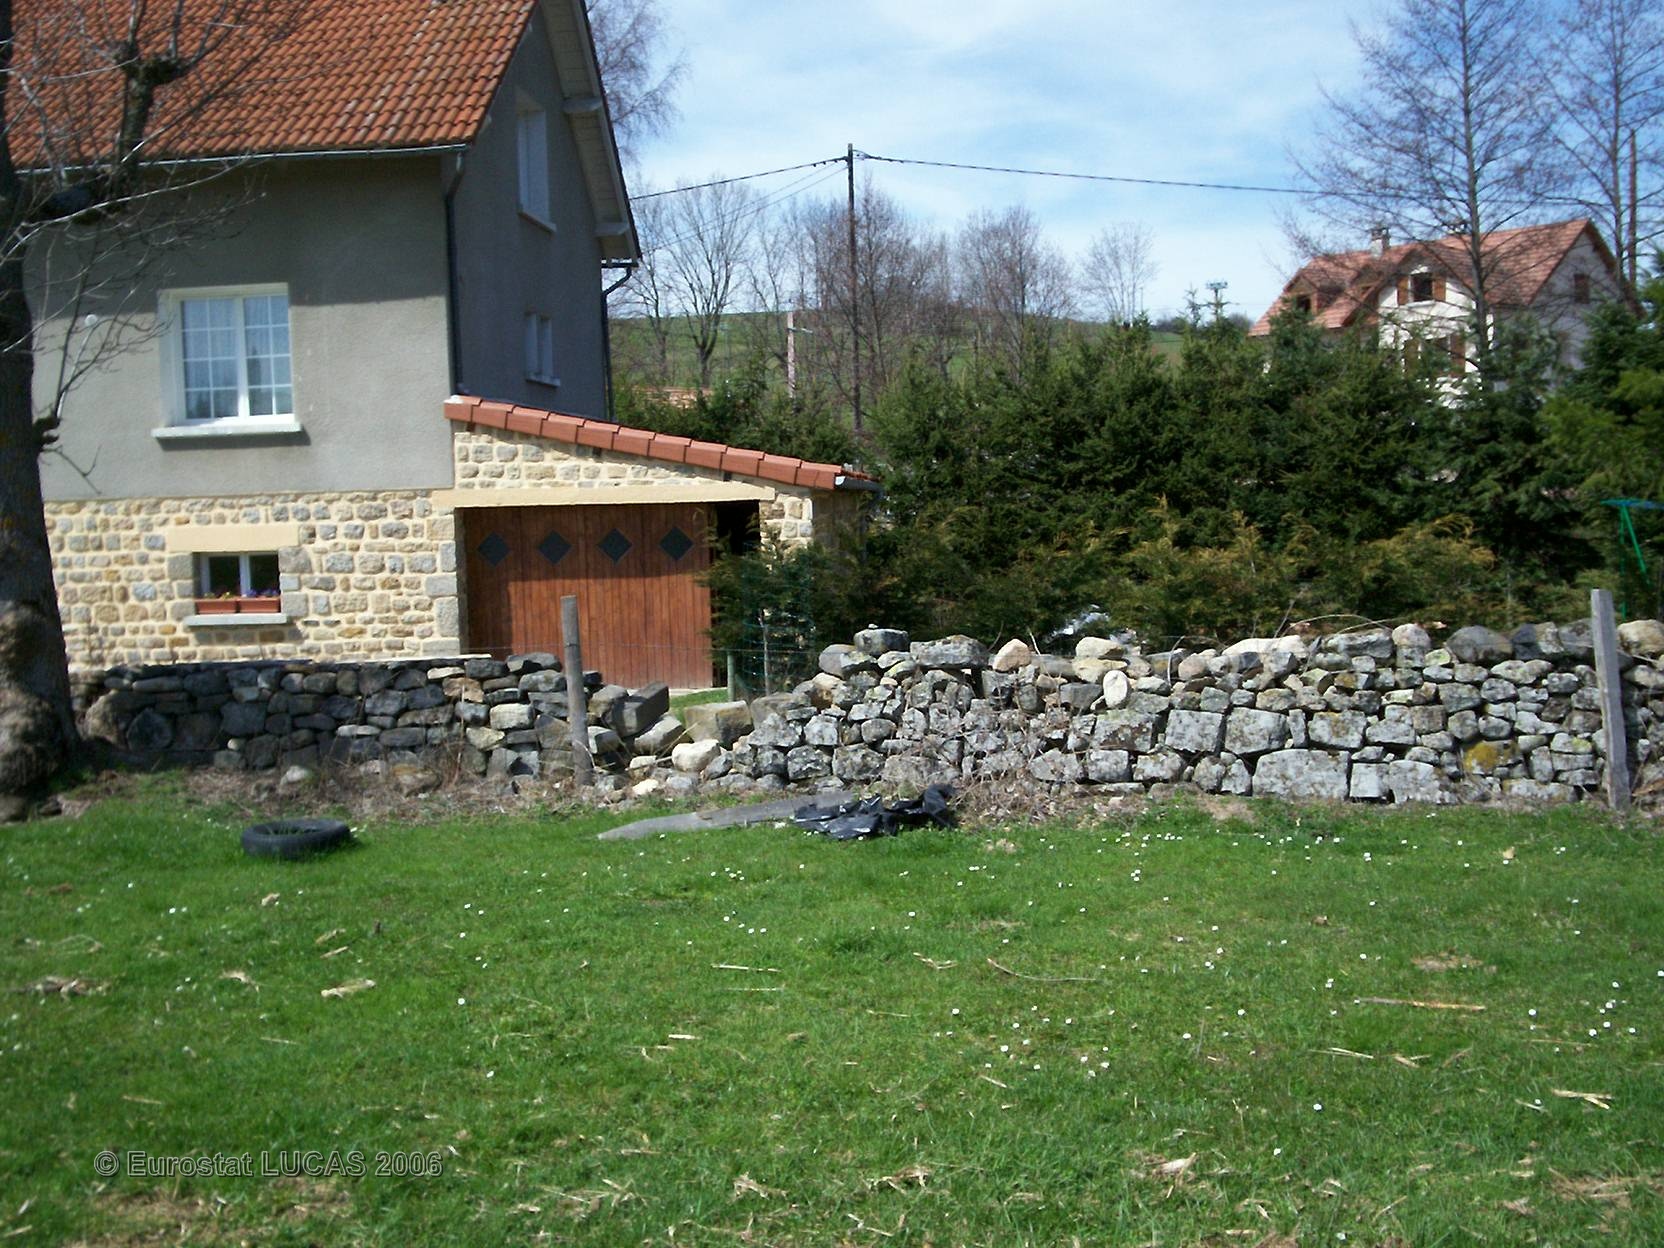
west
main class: Grassland
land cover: Grassland without tree/shrub cover
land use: Agriculture (excluding fallow land and kitchen gardens)
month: April
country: FR
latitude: 44.8597
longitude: 3.3344
